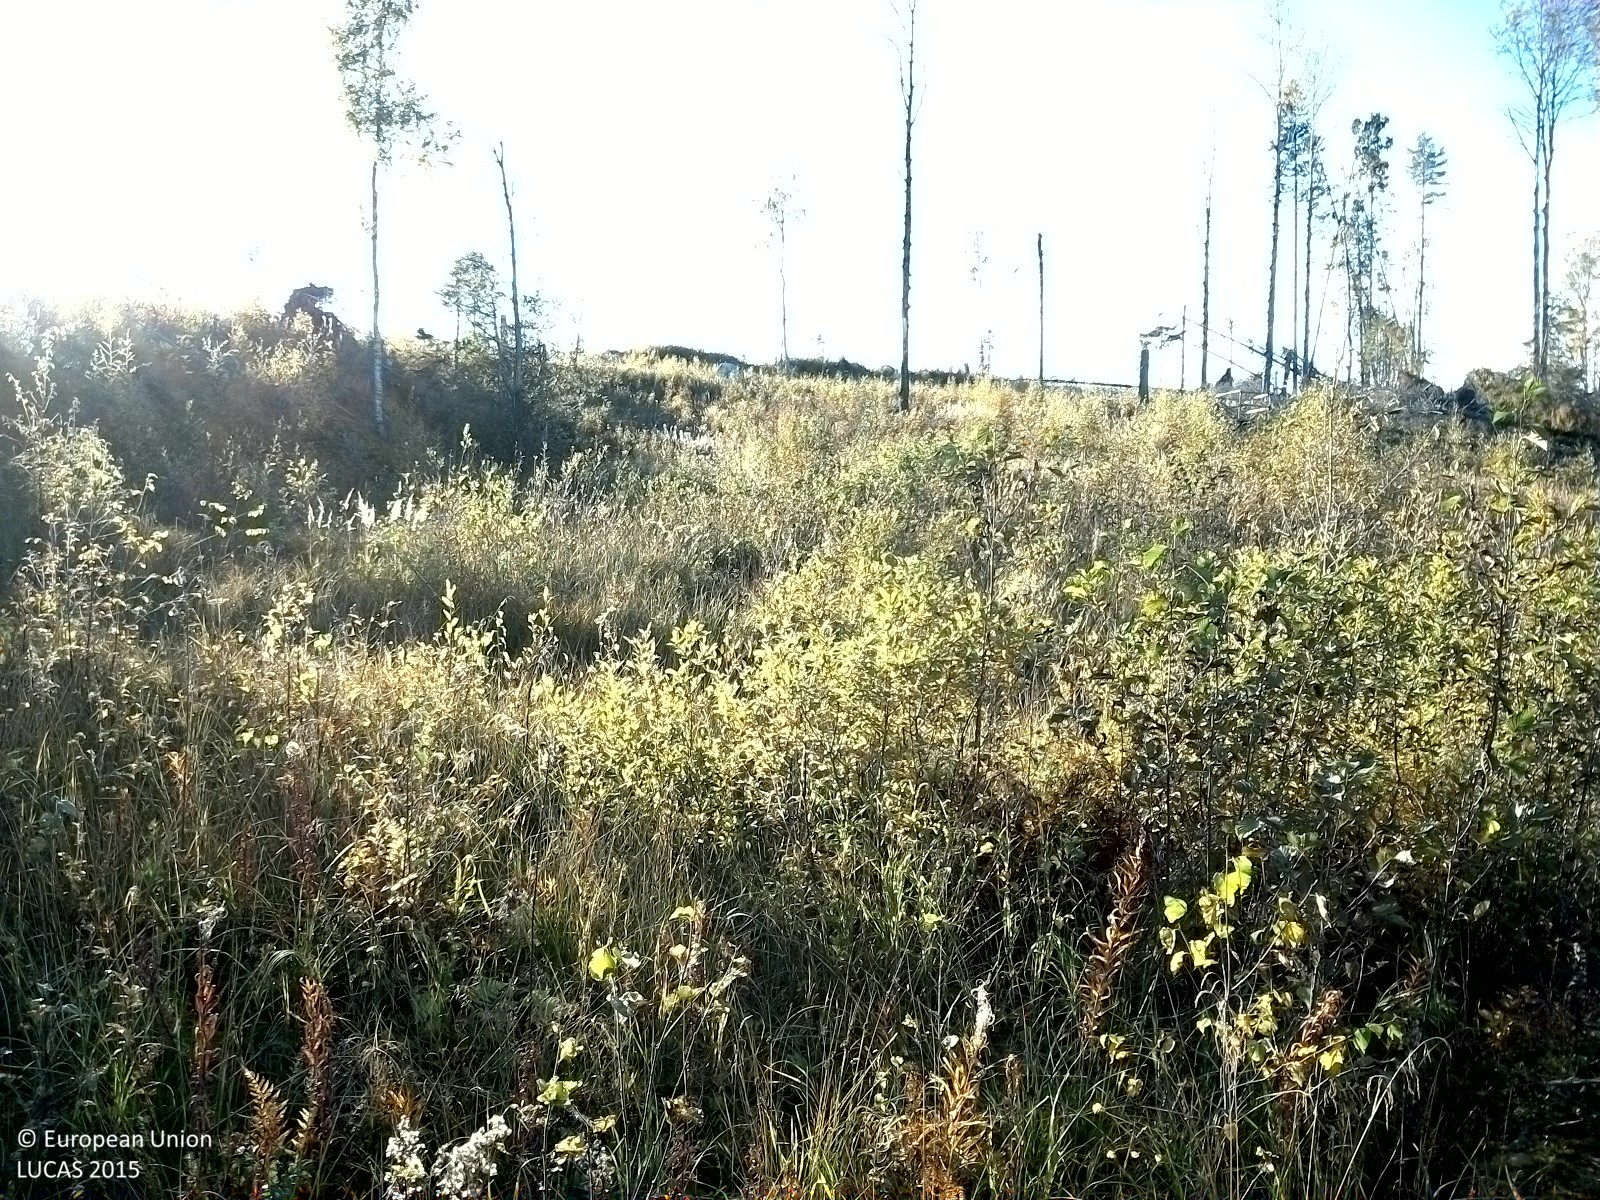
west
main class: Artificial land
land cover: Other artificial areas
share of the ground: > 75 %
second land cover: Broadleaved woodland
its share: > 75 %
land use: Electricity, gas and thermal power distribution
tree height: < 5 m
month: September
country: SE
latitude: 62.3987
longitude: 16.9255
